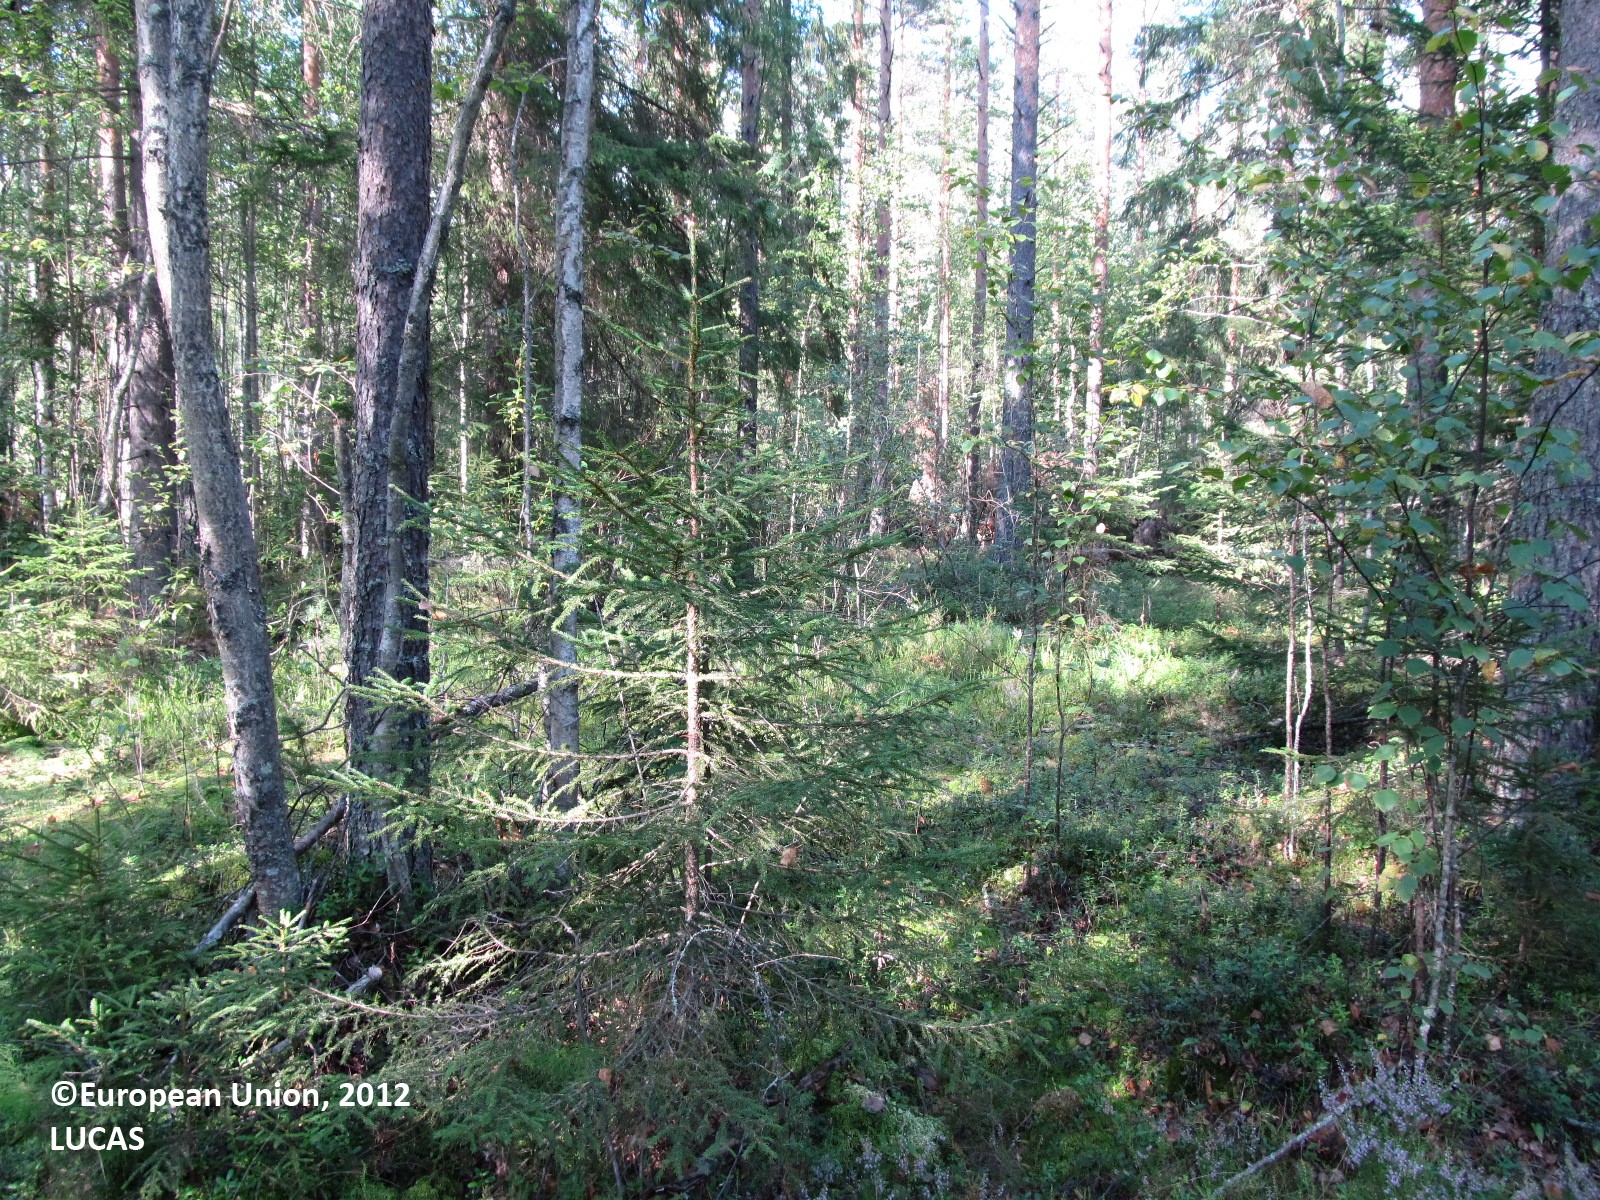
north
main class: Woodland
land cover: Pine dominated mixed woodland
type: boreal forest
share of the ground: 50 - 75 %
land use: Forestry
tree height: > 5 m
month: August
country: FI
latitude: 62.1672
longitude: 27.5078
